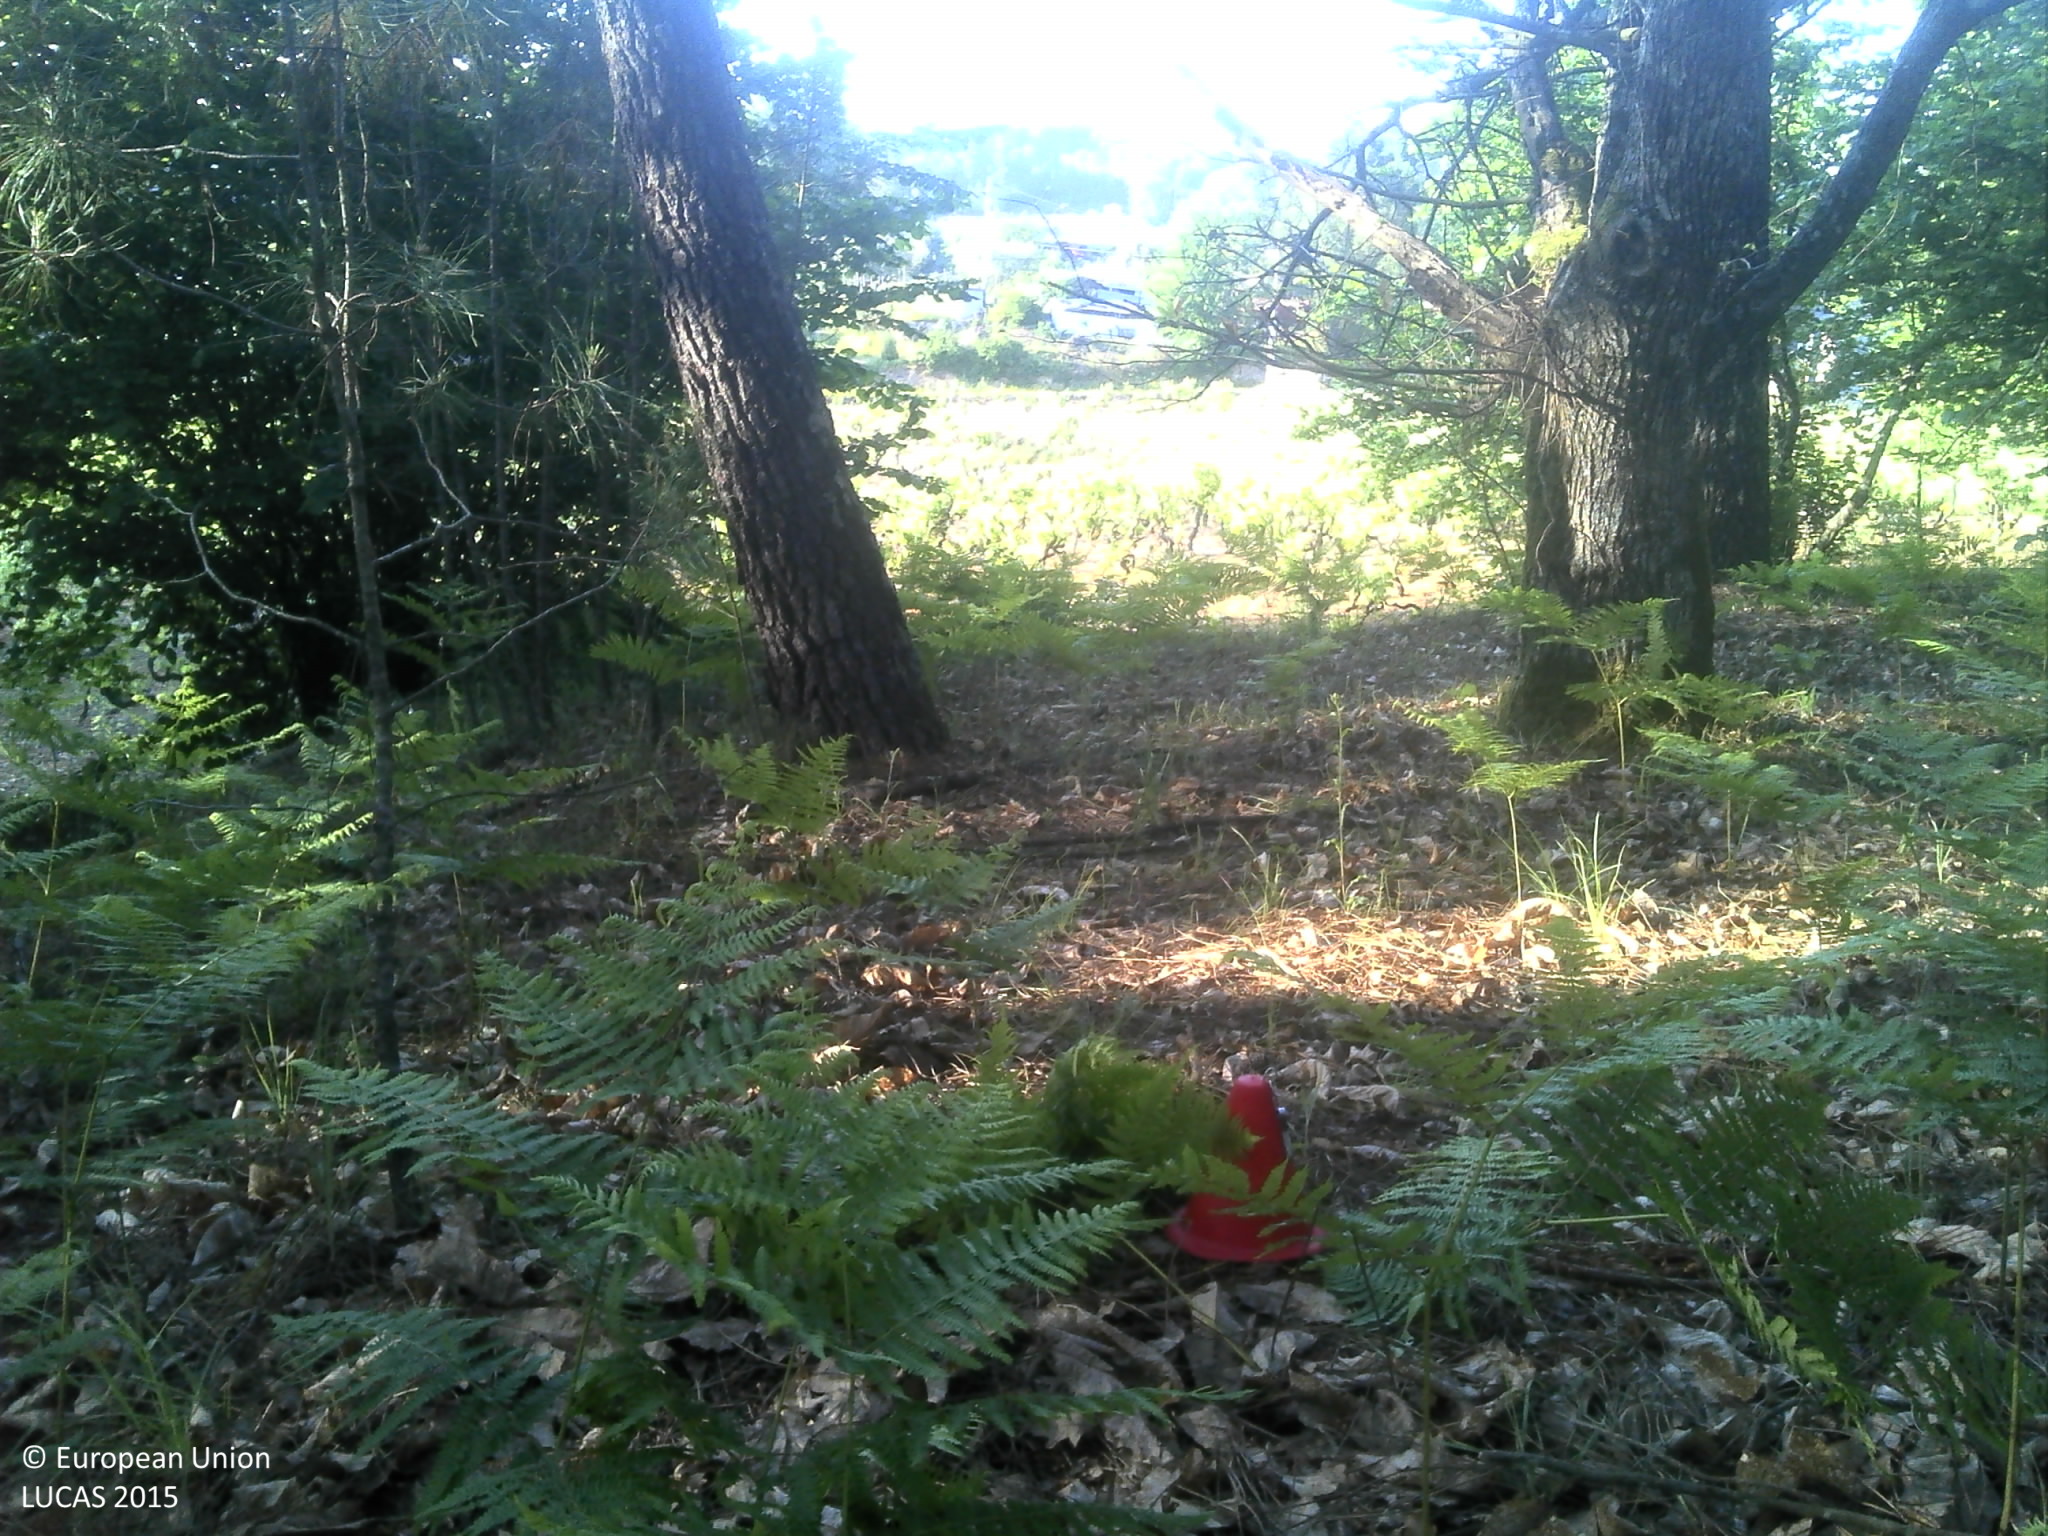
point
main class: Woodland
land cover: Pine dominated coniferous woodland
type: coniferous forest of the mediterranean region
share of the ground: 50 - 75 %
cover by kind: coniferous forest trees 100 %
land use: Forestry
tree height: > 5 m
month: May
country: PT
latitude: 40.6424
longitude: -7.7749
